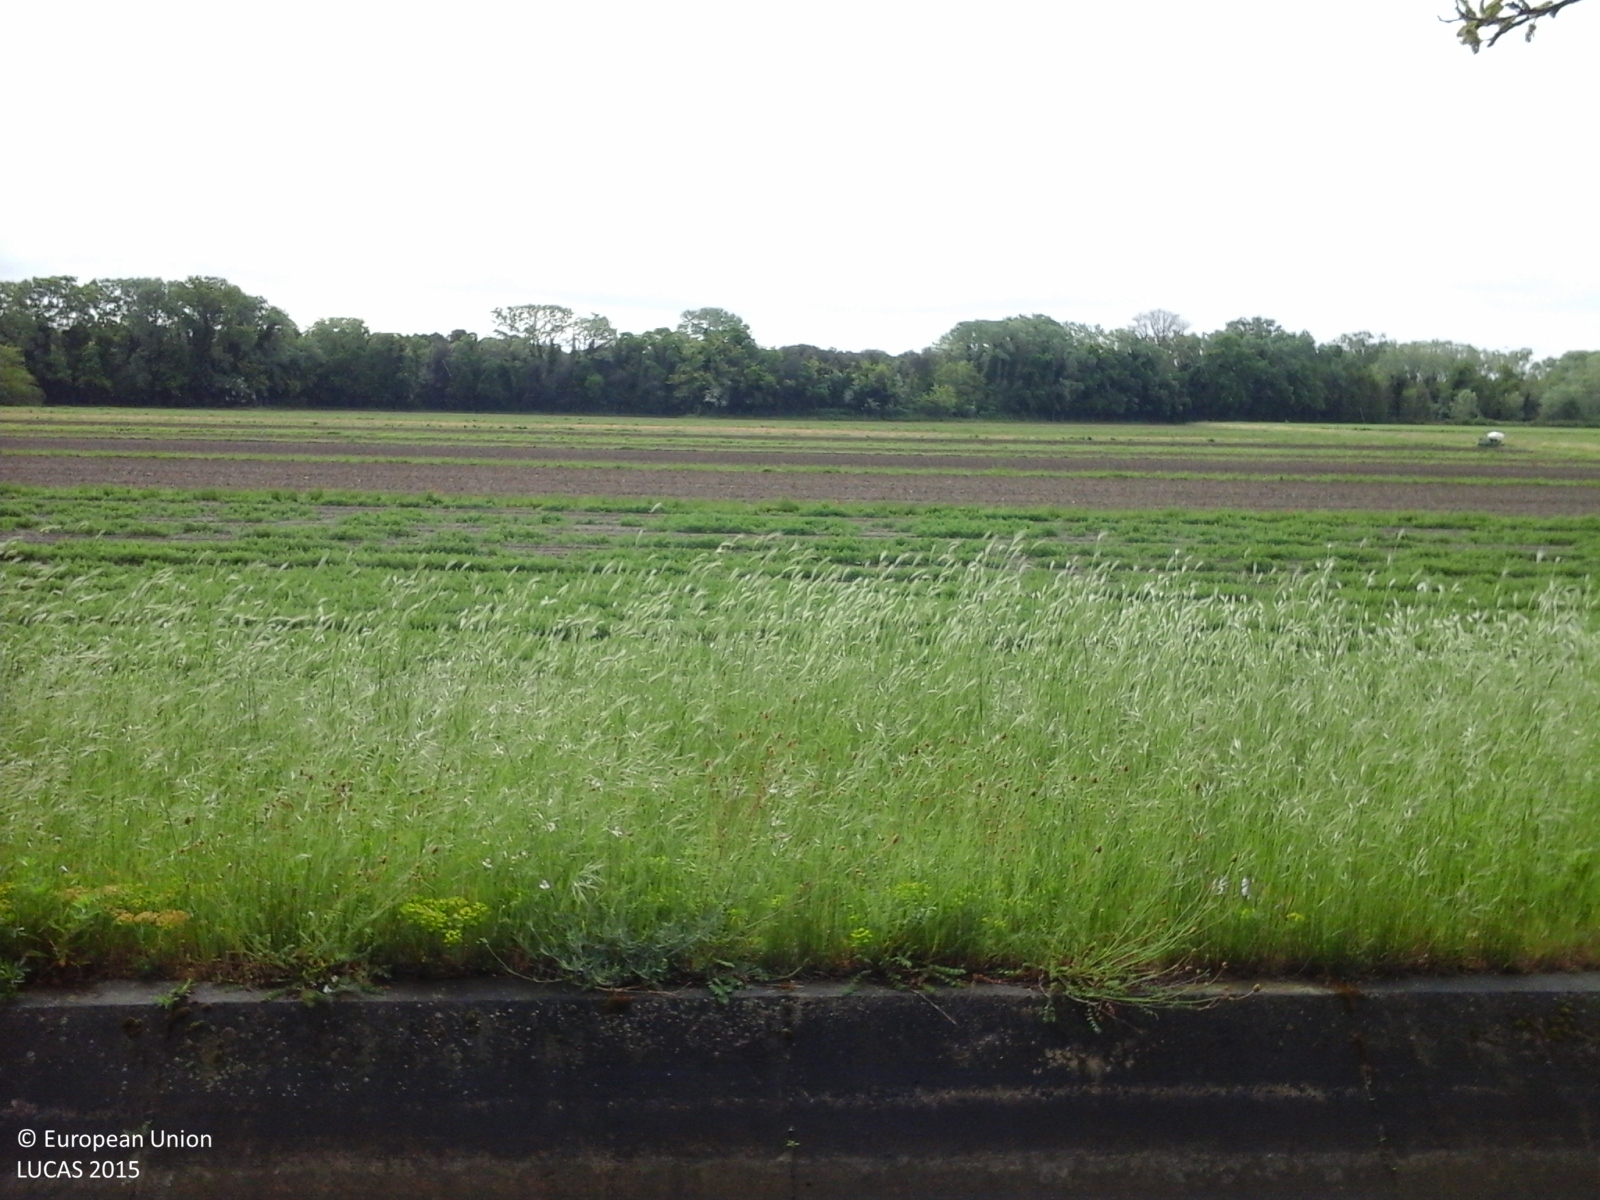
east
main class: Woodland
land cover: Broadleaved woodland
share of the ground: > 75 %
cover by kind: broadleaved forest trees 80 %, herbaceous plants 20 %
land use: Residential
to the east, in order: Broadleaved woodland; Fences; Grass margins; Tracks; Inland fresh running water; Spontaneously vegetated surfaces; Ditches and canals; Grass margins; Other root crops; Grass margins; Ditches and canals; Grass margins; Maize; Grass margins; Ditches and canals; Grass margins; Maize; Ditches and canals; Grass margins; Inland fresh running water; Maize
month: April
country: IT
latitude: 44.8851
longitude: 12.2620
